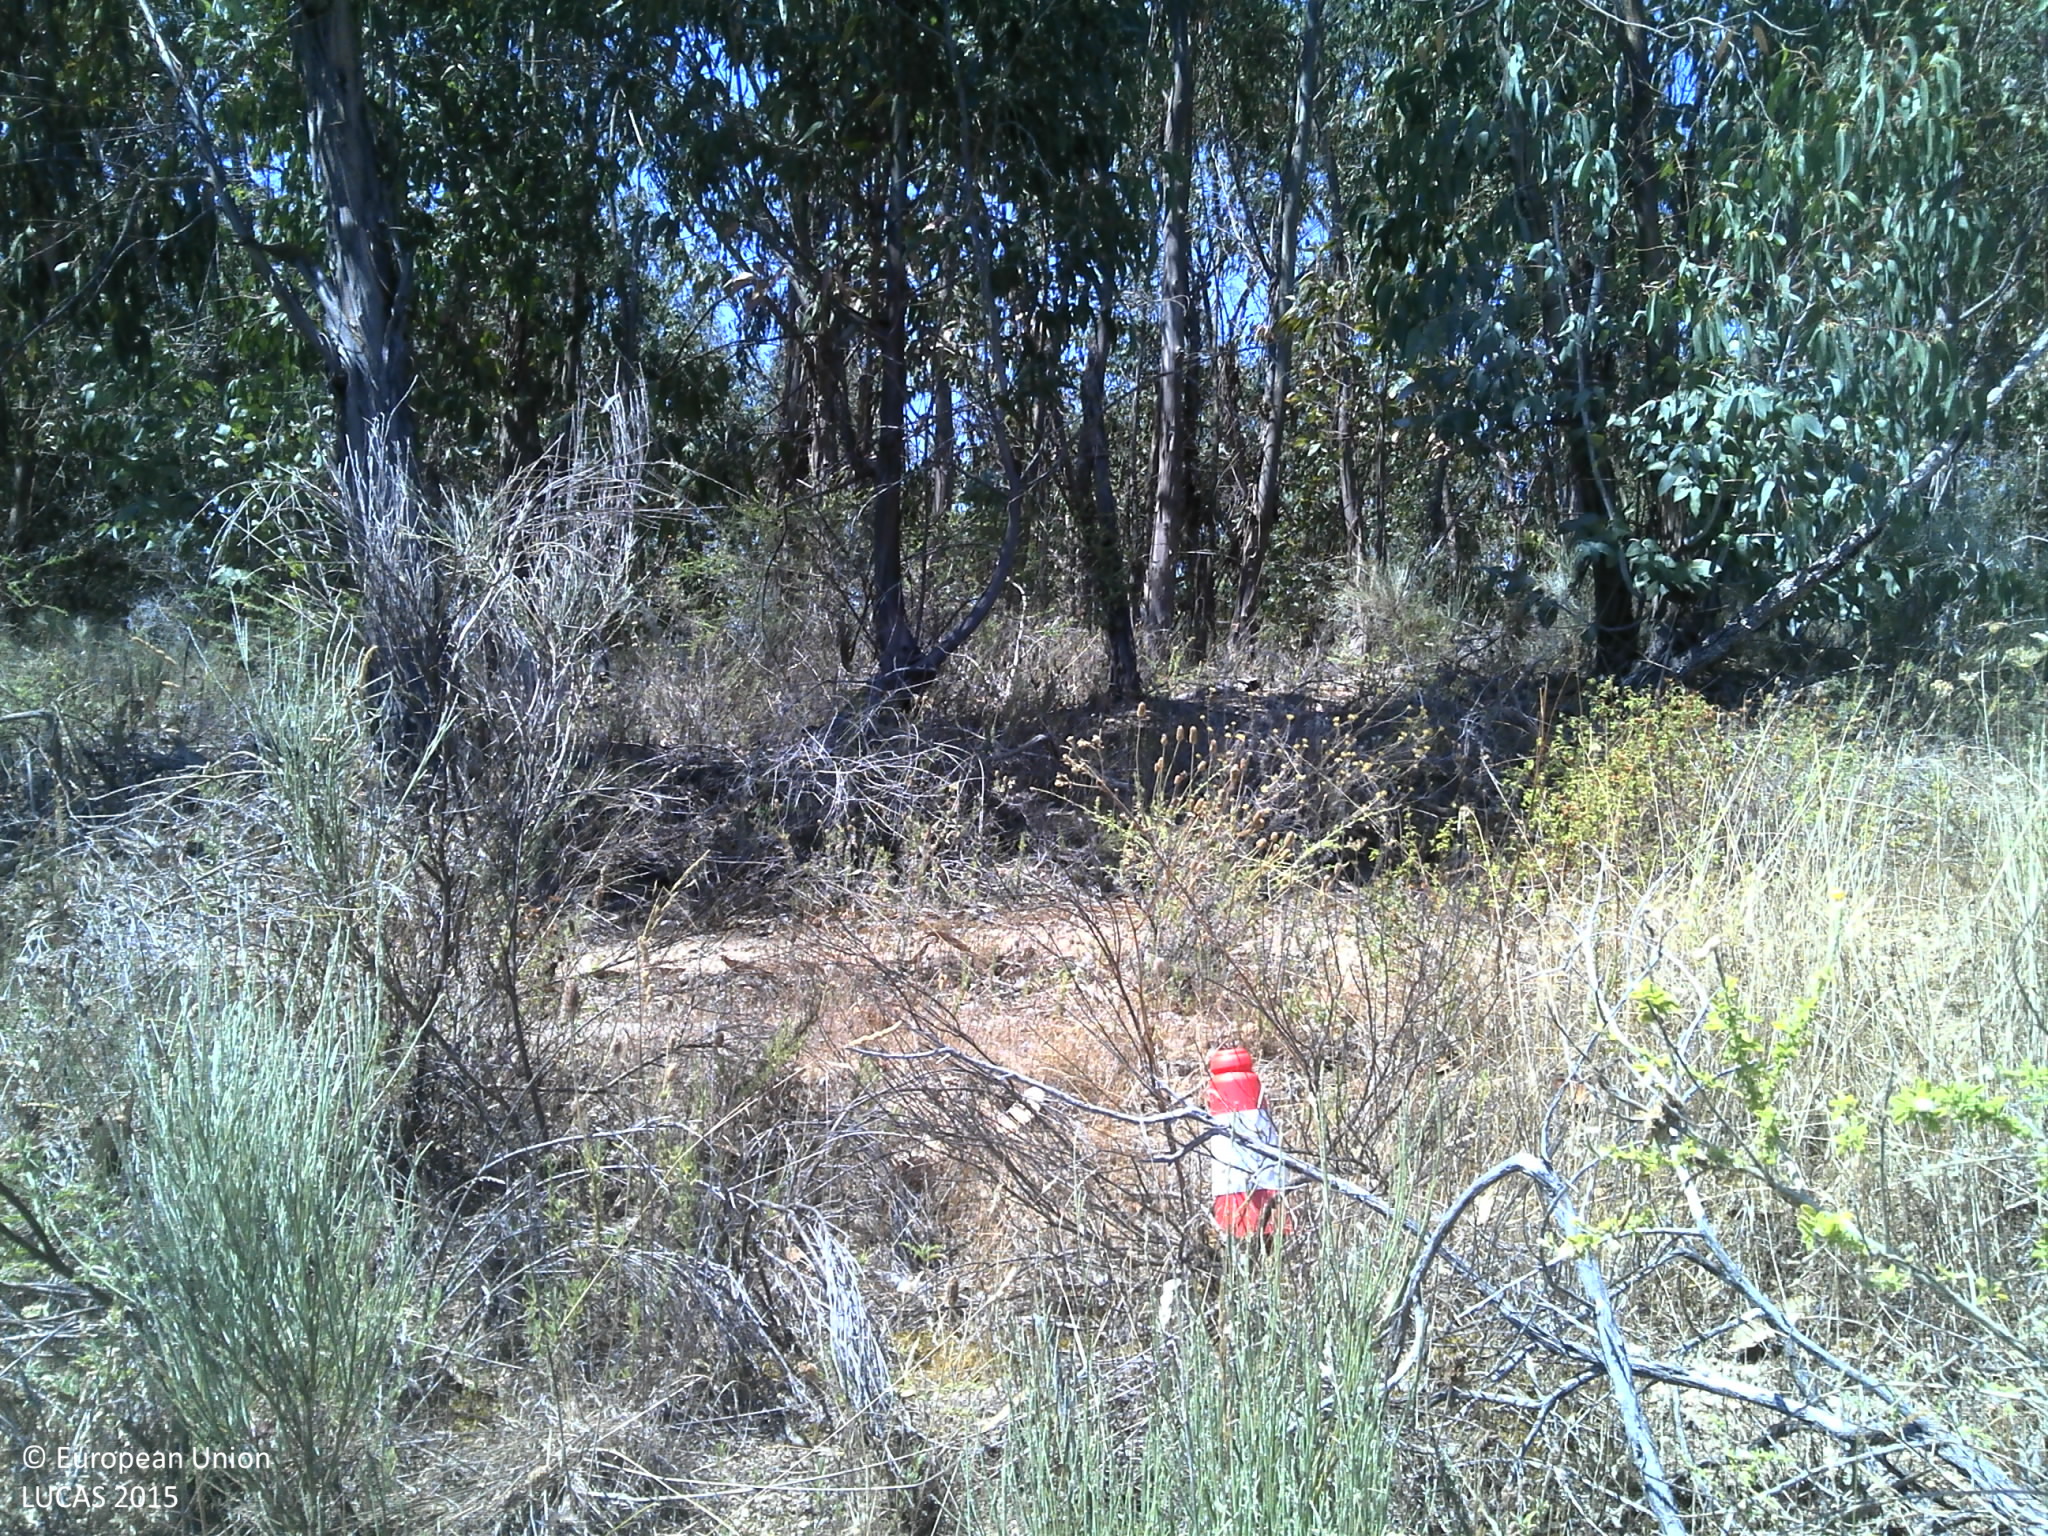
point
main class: Woodland
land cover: Broadleaved woodland
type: exotic forest
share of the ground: 25 - 50 %
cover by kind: broadleaved forest trees 50 %, shrubs 20 %, unconsolidated bare surface 15 %, herbaceous plants 10 %
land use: Forestry
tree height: > 5 m
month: June
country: PT
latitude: 40.0469
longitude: -7.2933
